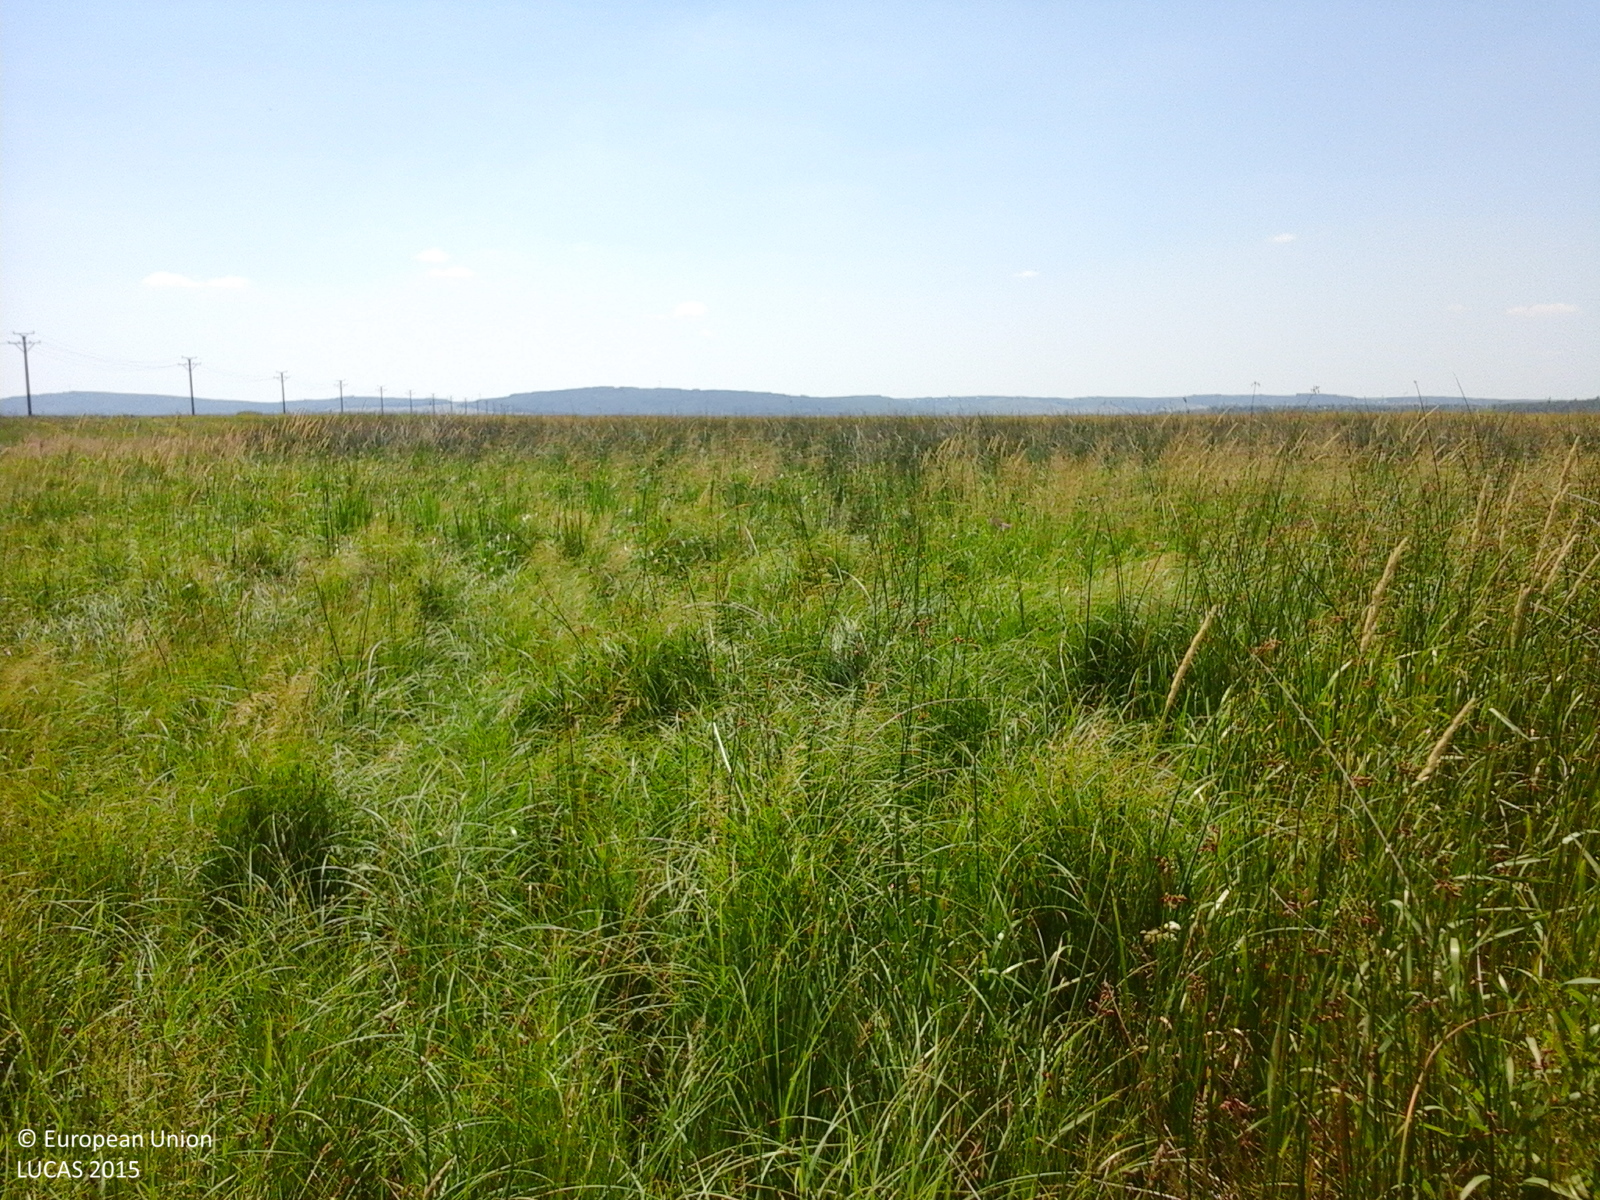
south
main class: Grassland
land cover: Grassland without tree/shrub cover
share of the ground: > 75 %
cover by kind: herbaceous plants 100 %
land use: Agriculture (excluding fallow land and kitchen gardens)
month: June
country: RO
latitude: 47.3741
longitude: 27.5338
